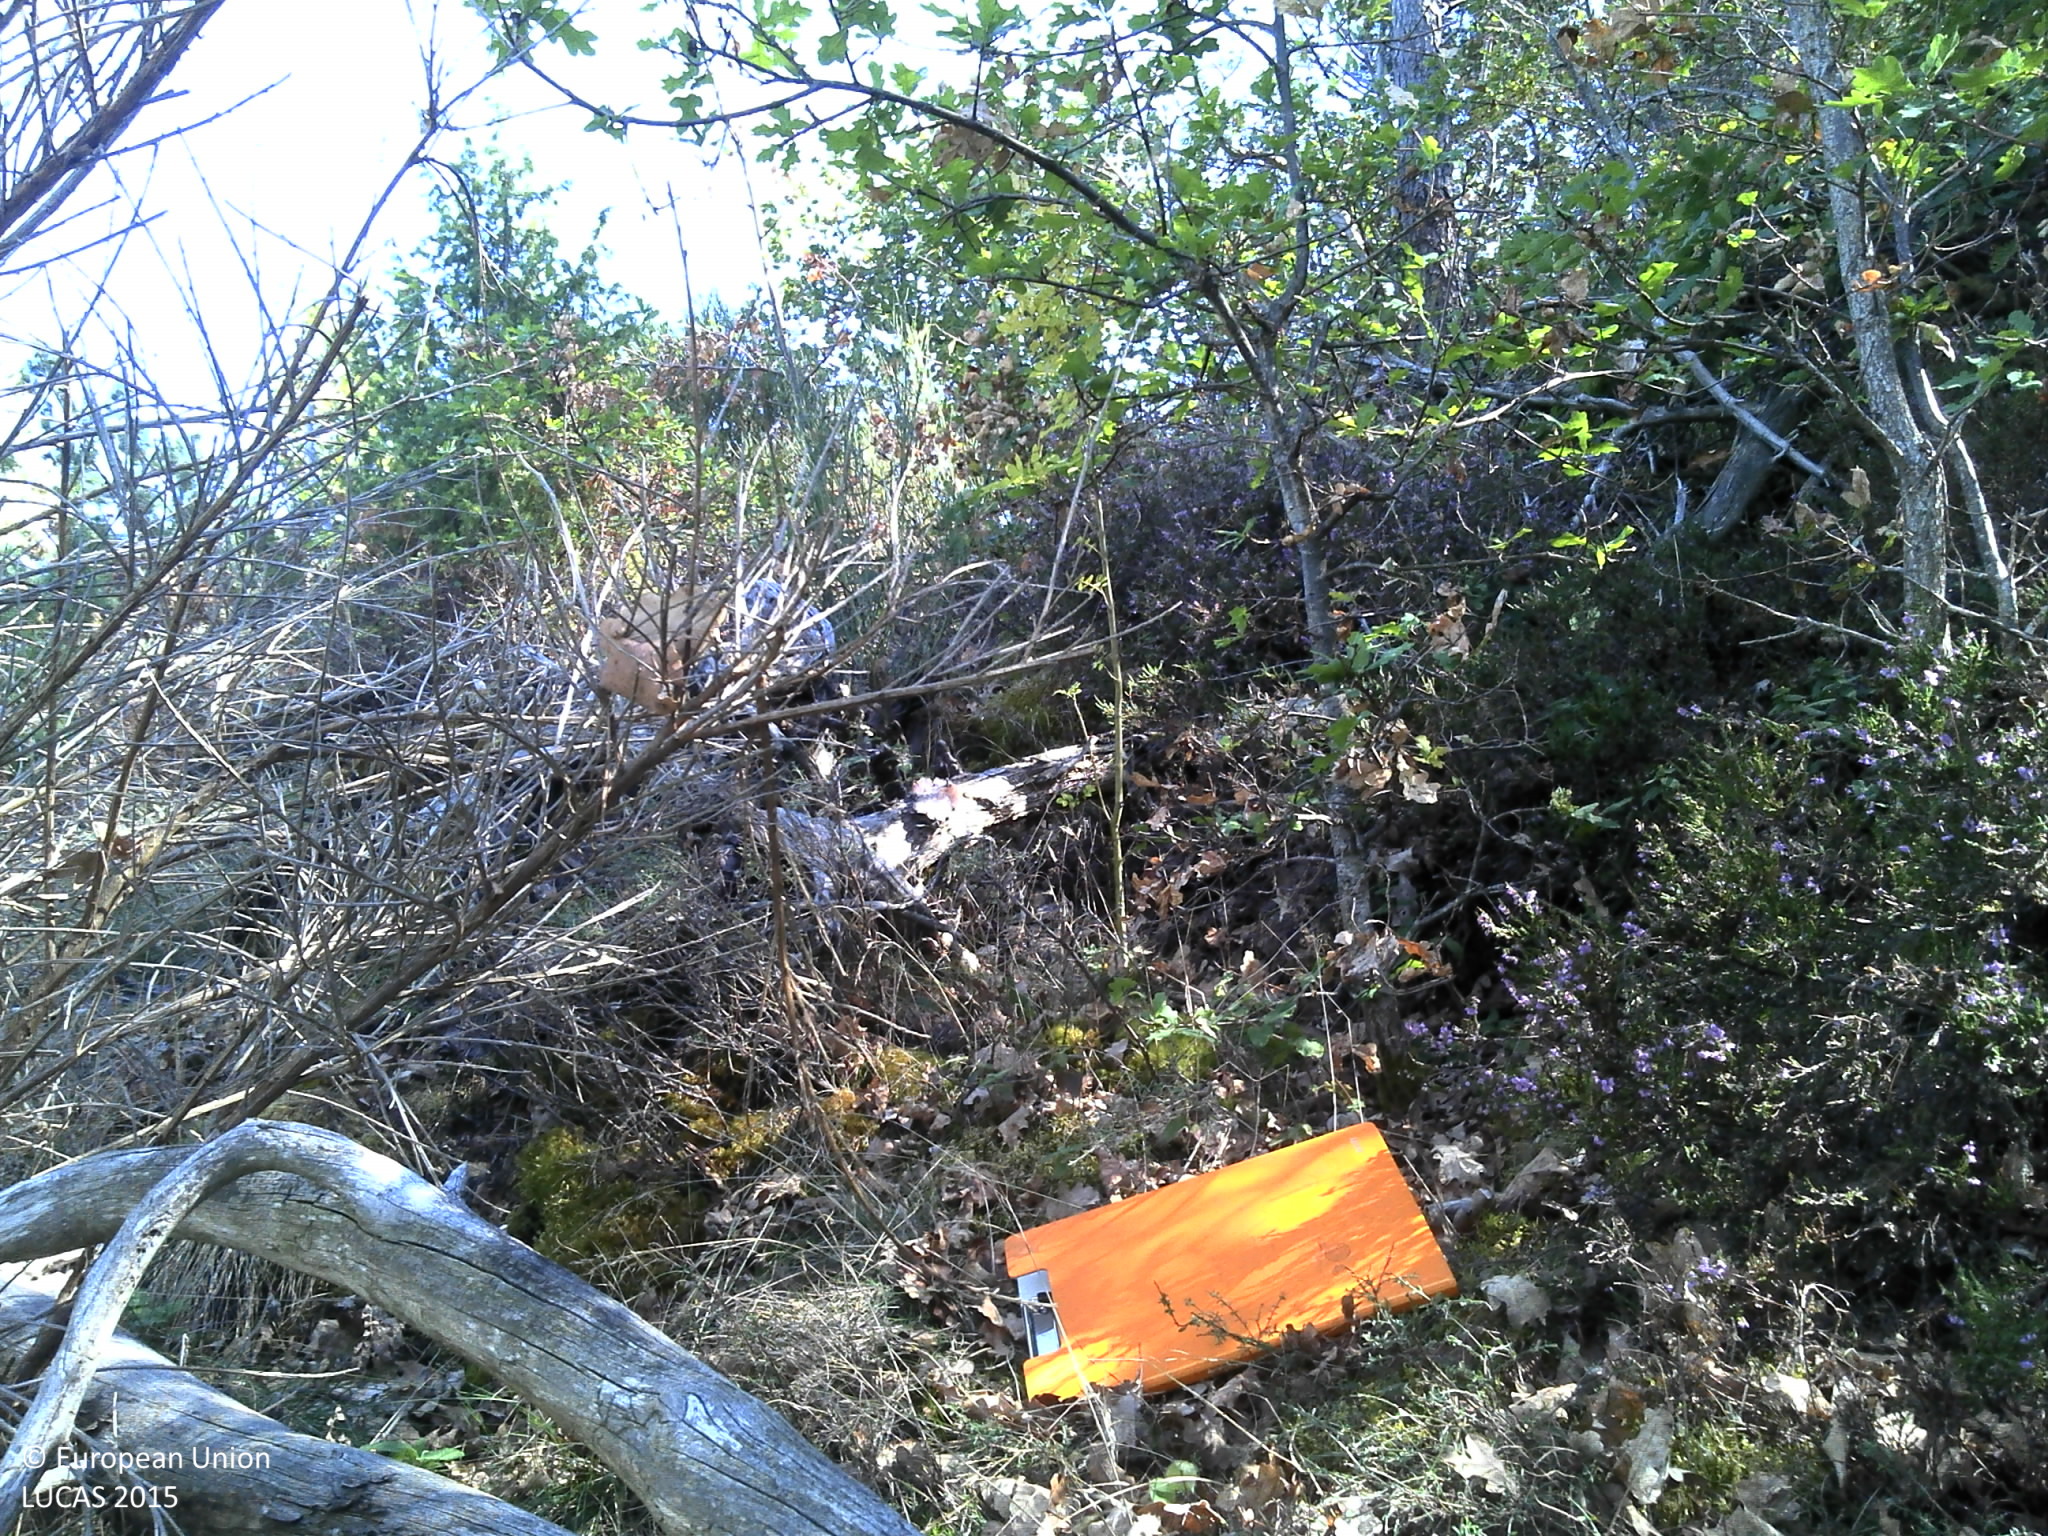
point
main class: Woodland
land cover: Pine dominated mixed woodland
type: alpine coniferous forest
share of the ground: 50 - 75 %
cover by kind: coniferous forest trees 40 %, broadleaved forest trees 30 %, shrubs 10 %, herbaceous plants 5 %, lichens and mosses 5 %, consolidated bare surface 5 %, unconsolidated bare surface 5 %
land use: Forestry
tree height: > 5 m
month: September
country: FR
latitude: 45.6555
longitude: 3.0573
